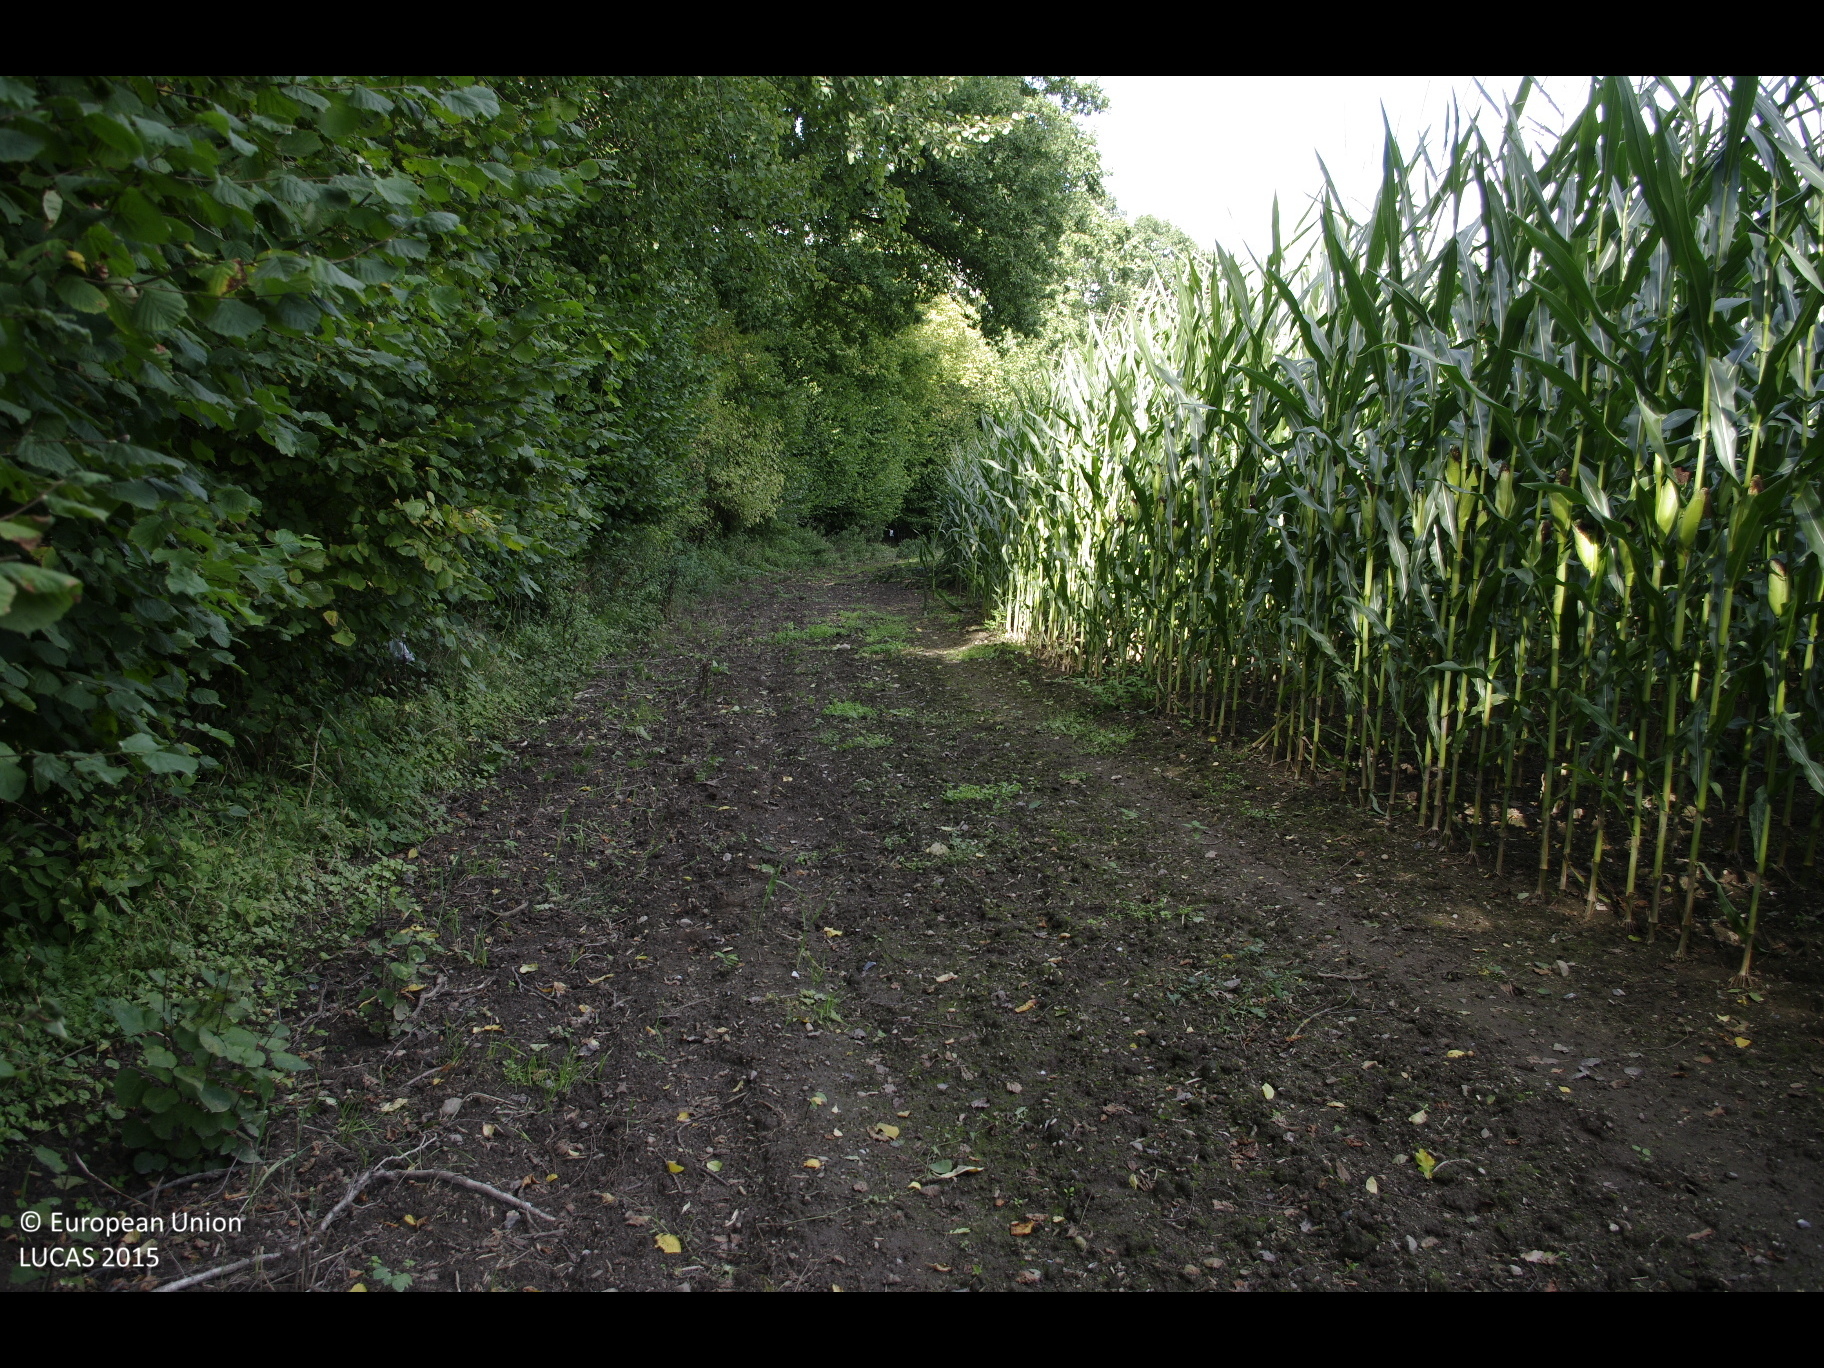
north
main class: Woodland
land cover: Broadleaved woodland
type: mire and swamp forests
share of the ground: 50 - 75 %
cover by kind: broadleaved forest trees 70 %, herbaceous plants 30 %
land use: Semi-natural and natural areas not in use
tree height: > 5 m
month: September
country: DE
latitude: 53.5441
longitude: 10.6184
